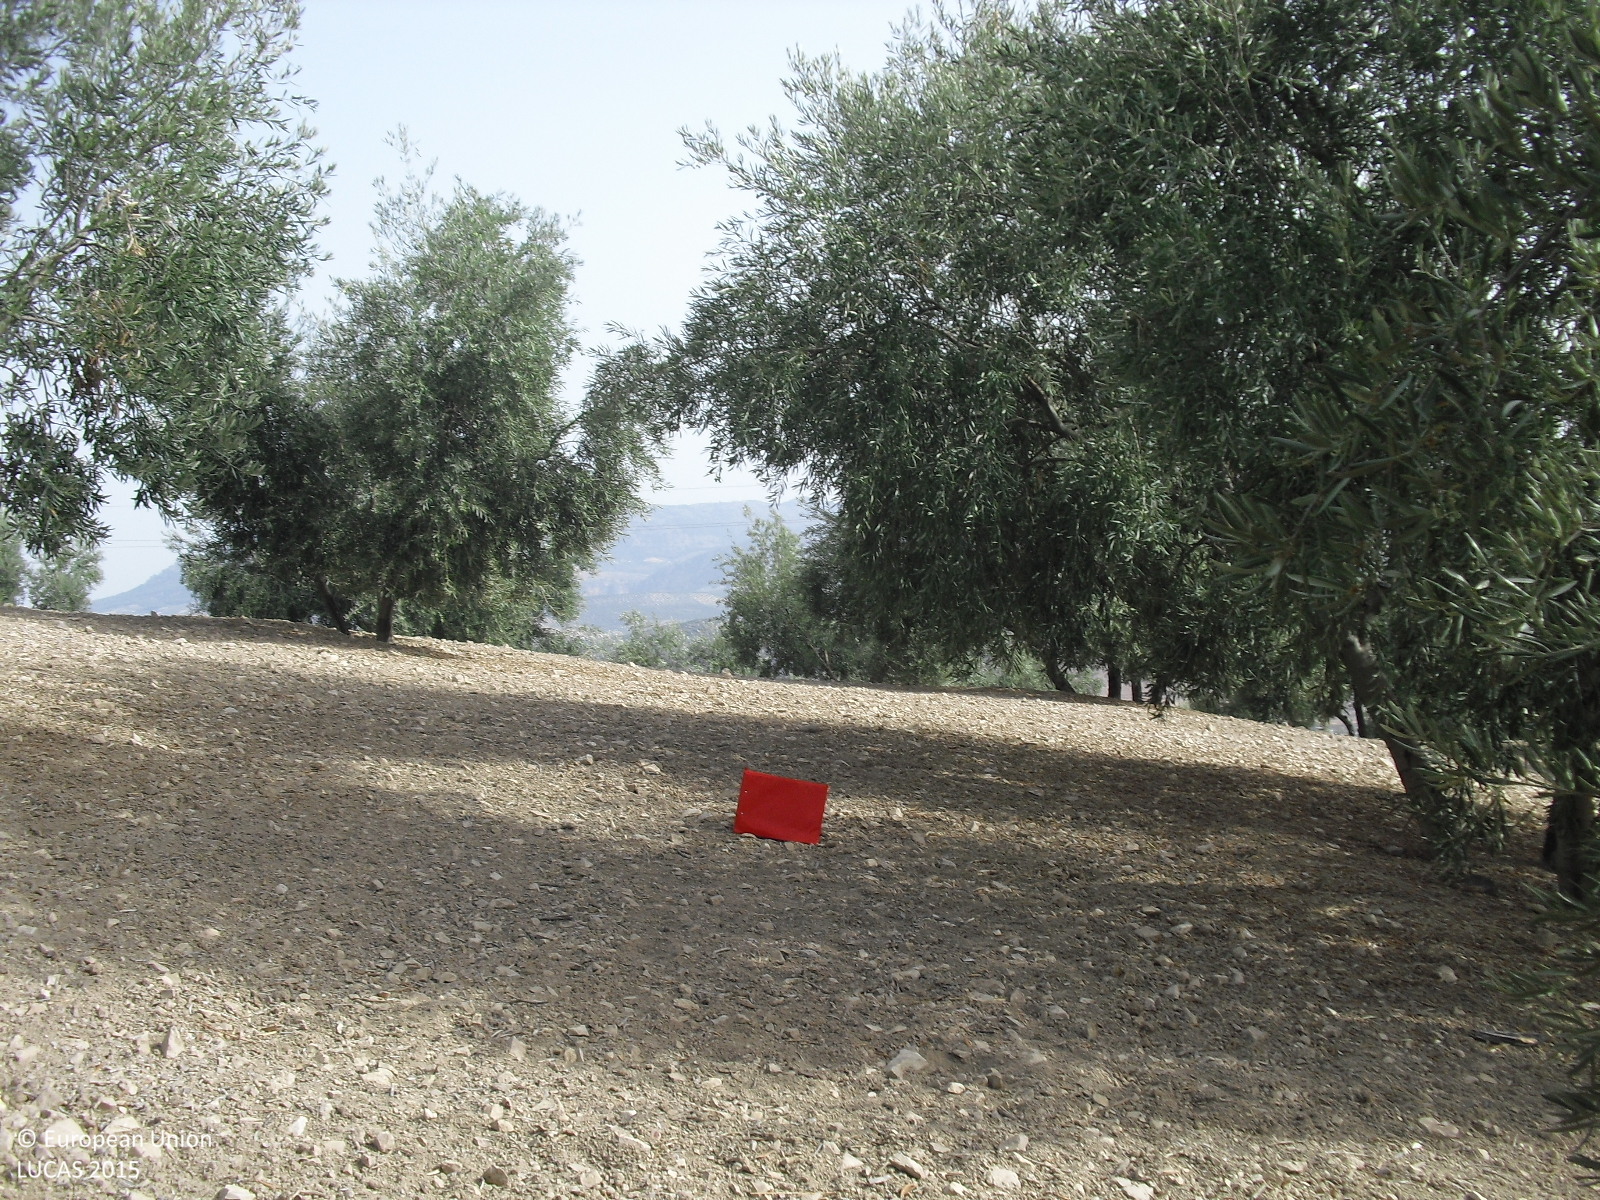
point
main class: Cropland
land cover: Olive groves
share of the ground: 25 - 50 %
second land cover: Other bare soil
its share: > 75 %
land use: Agriculture (excluding fallow land and kitchen gardens)
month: August
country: ES
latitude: 37.2450
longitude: -4.3263
